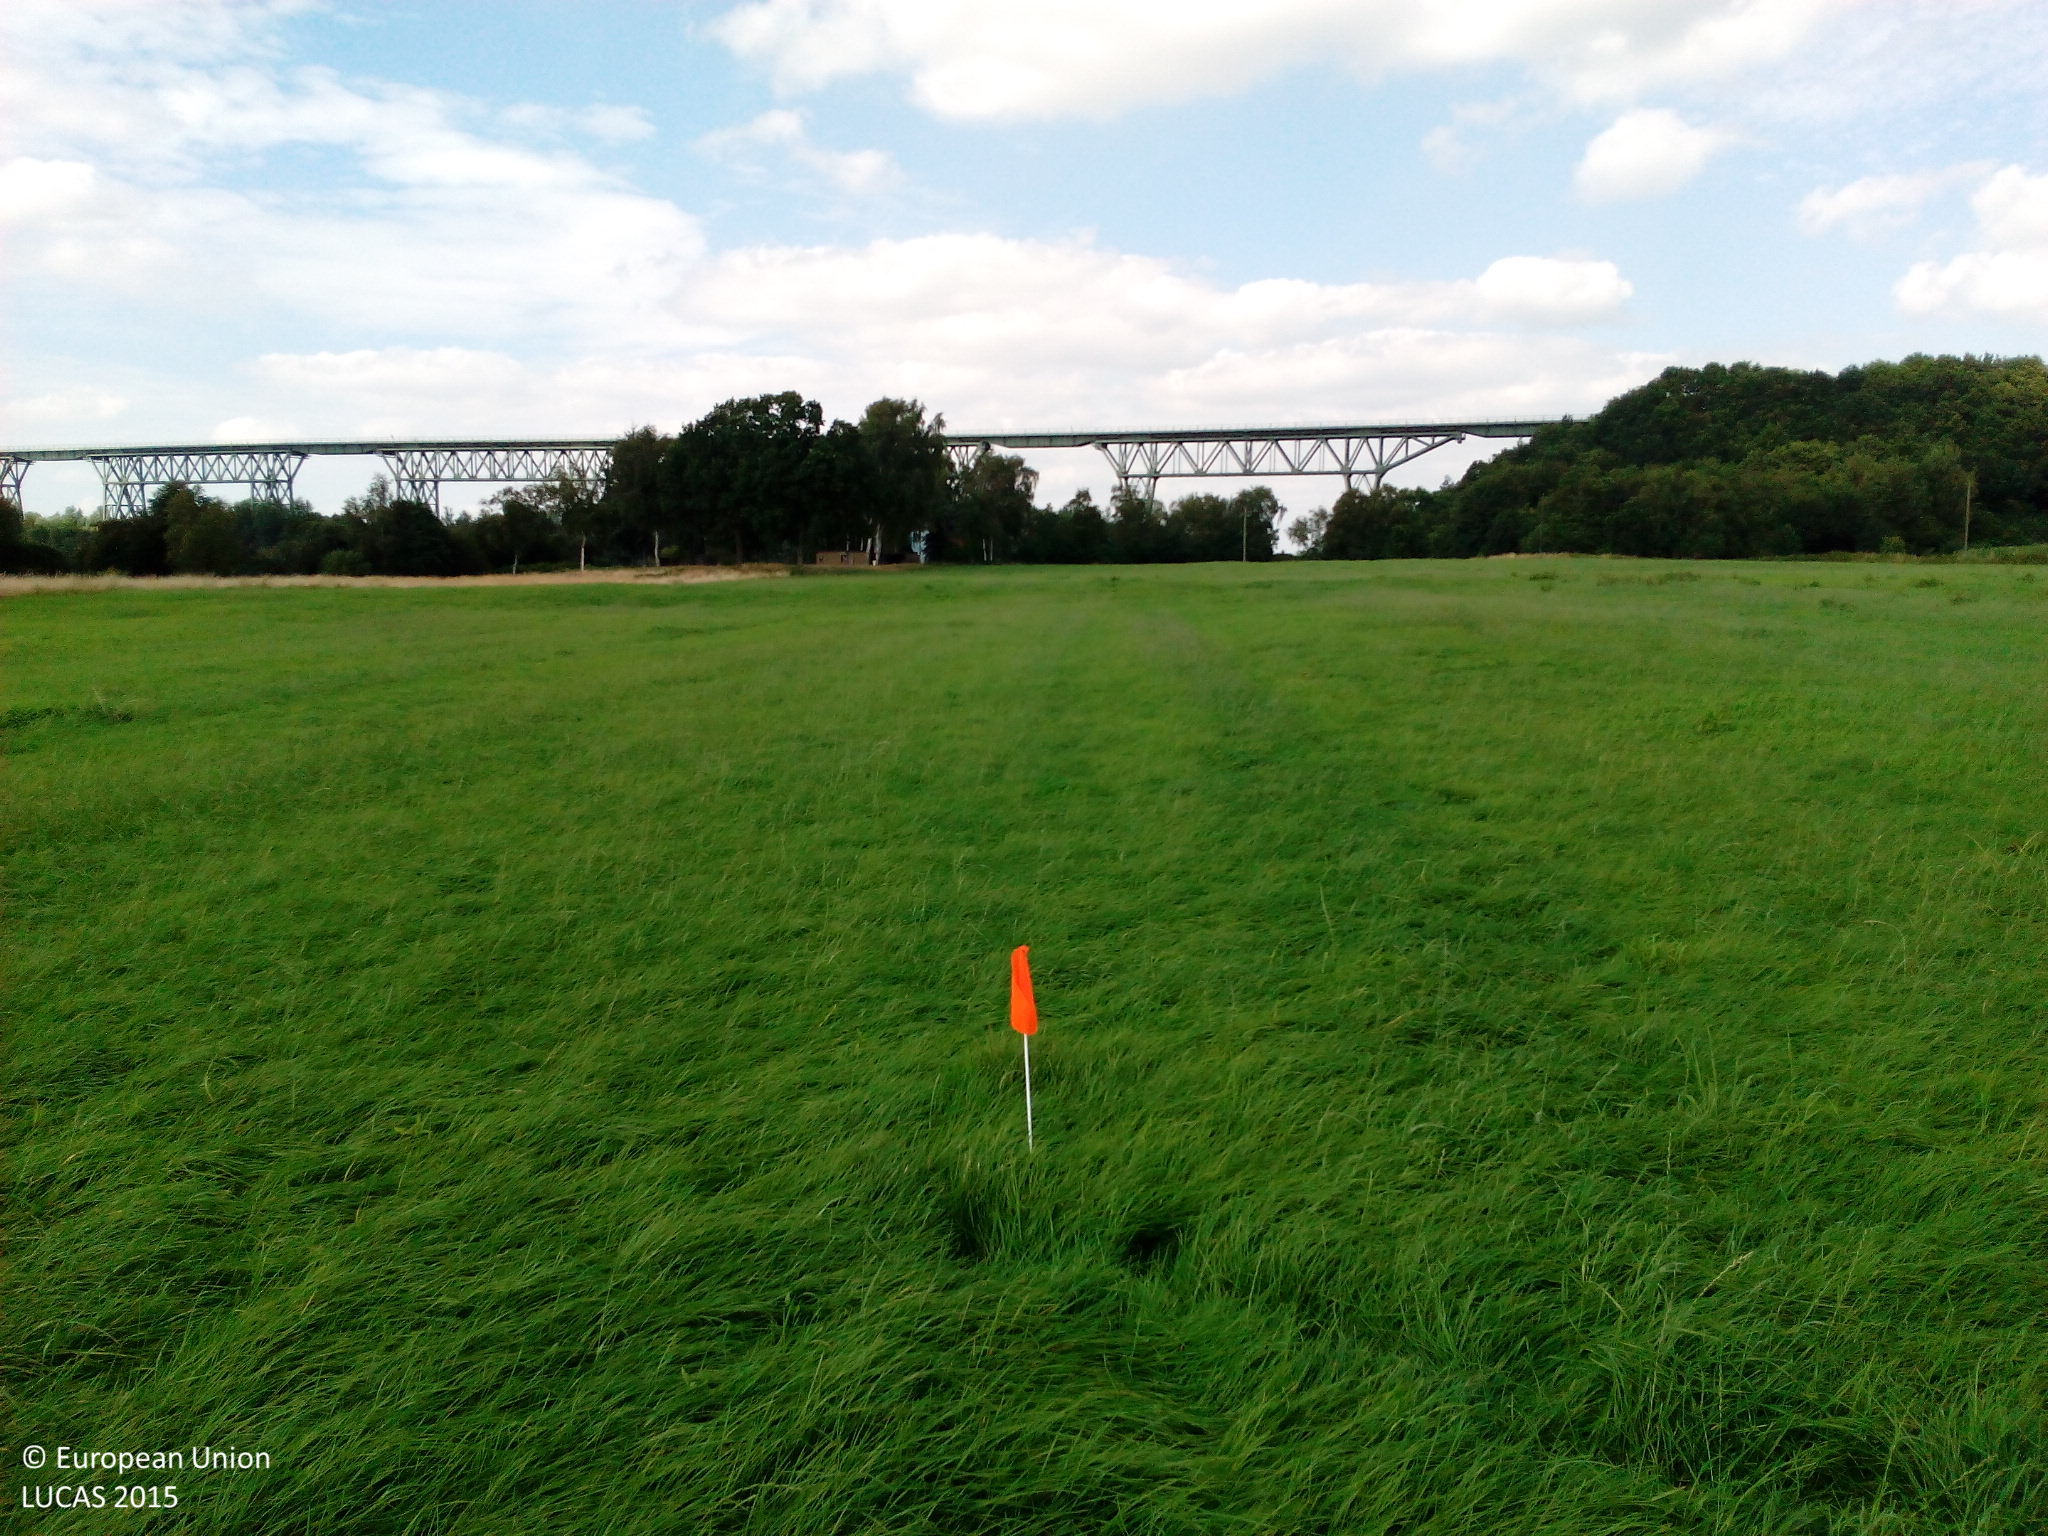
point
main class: Grassland
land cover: Grassland without tree/shrub cover
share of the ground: > 75 %
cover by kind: herbaceous plants 100 %
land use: Agriculture (excluding fallow land and kitchen gardens)
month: August
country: DE
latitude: 54.0110
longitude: 9.3137
